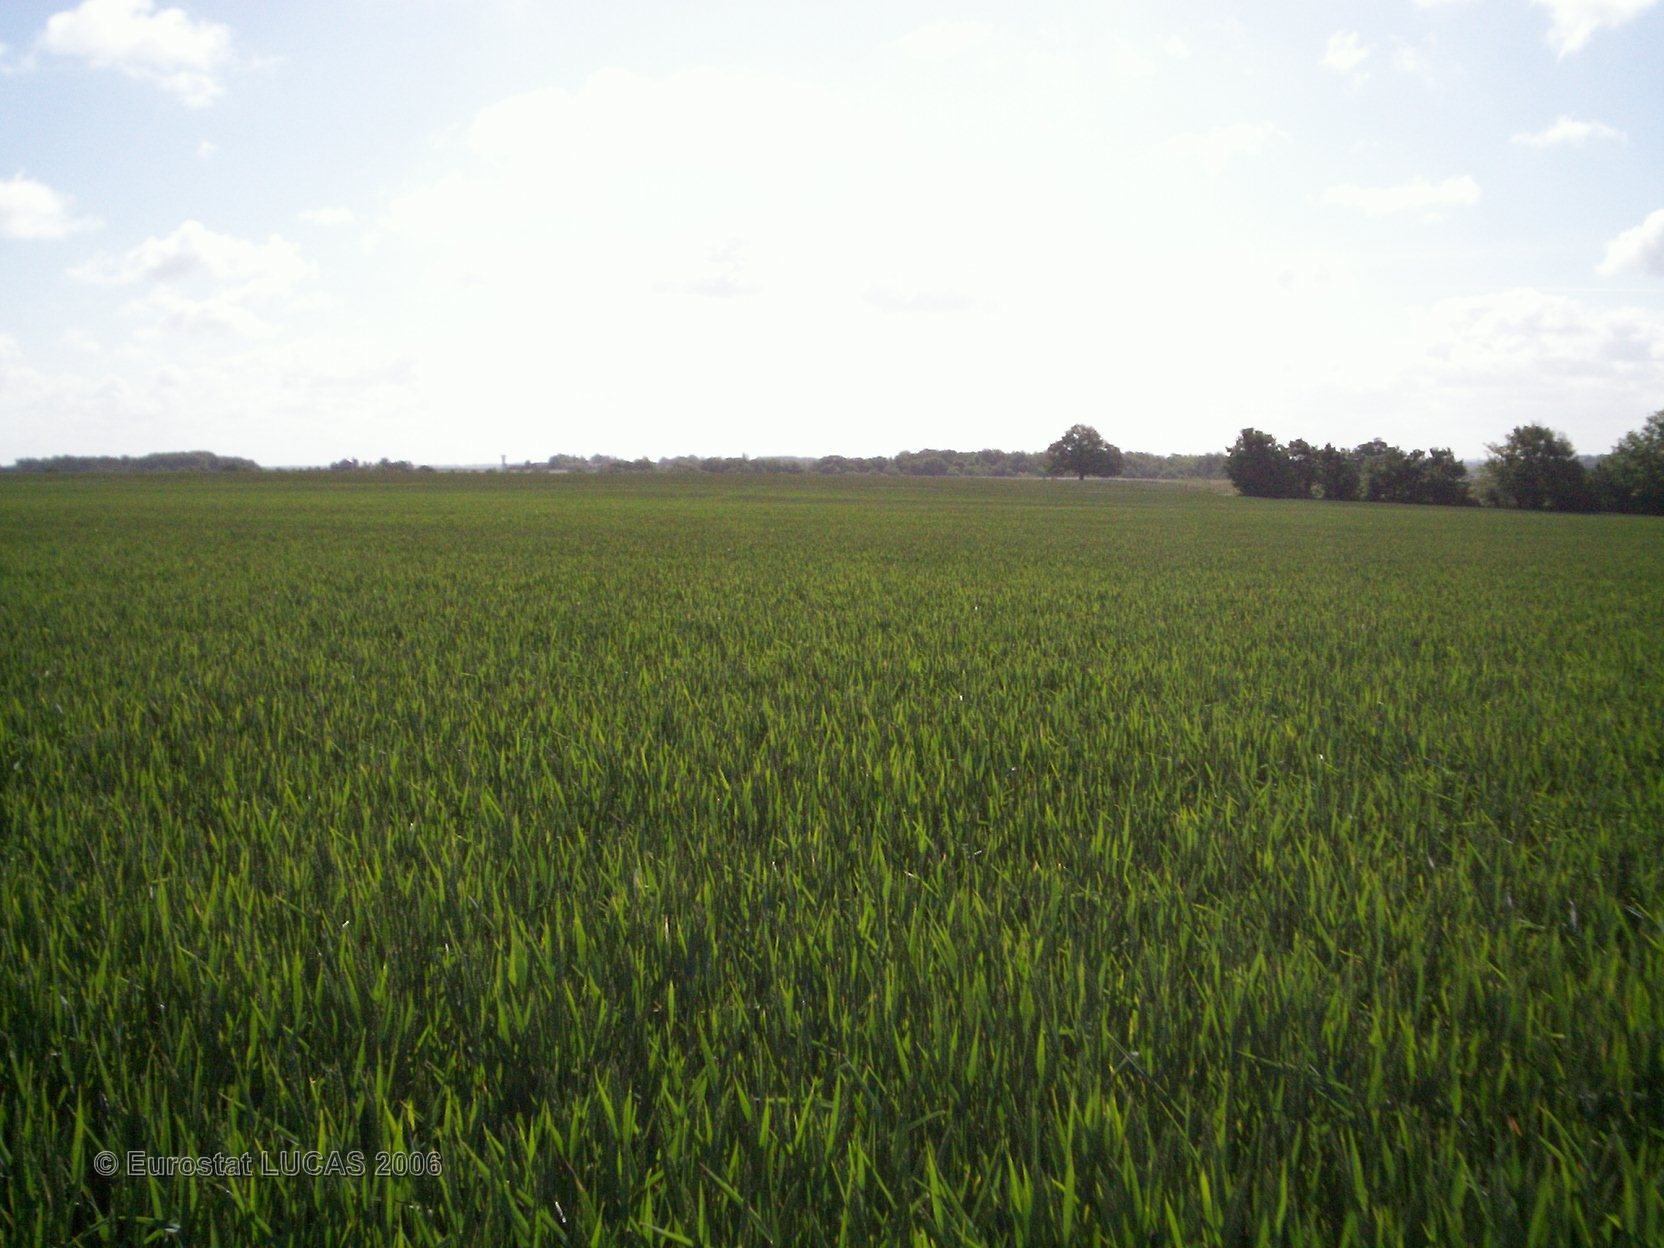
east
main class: Cropland
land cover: Common wheat
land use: Agriculture (excluding fallow land and kitchen gardens)
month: May
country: FR
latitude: 47.5171
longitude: 0.8584
